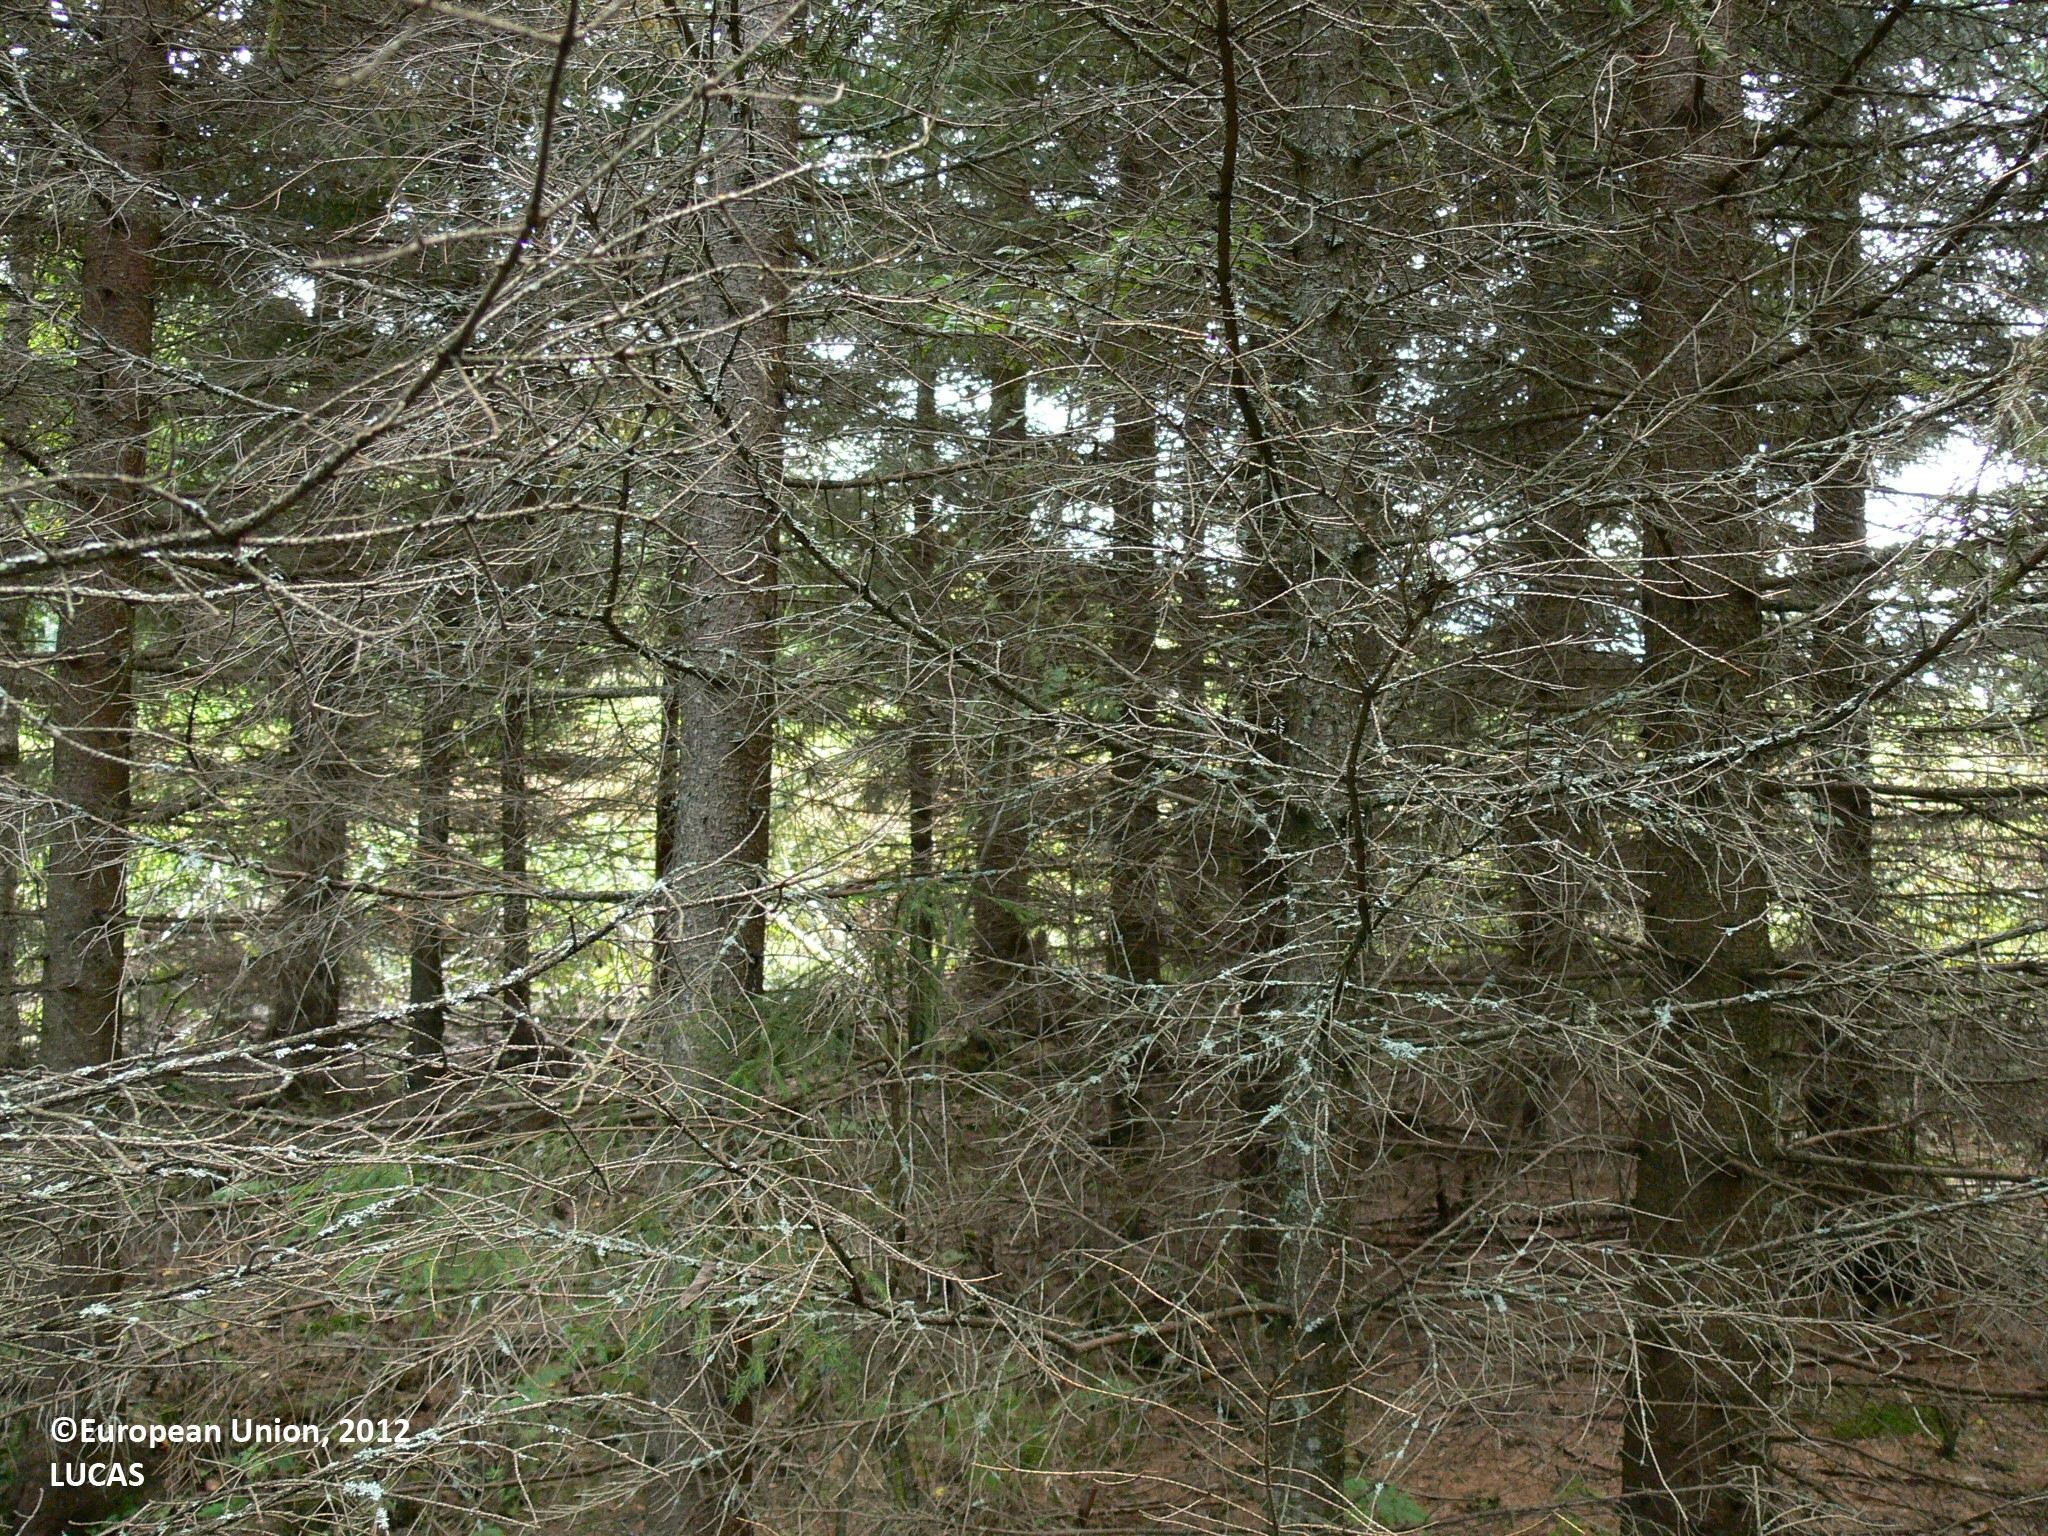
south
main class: Woodland
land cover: Spruce dominated coniferous woodland
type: boreal forest
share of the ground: > 75 %
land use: Forestry
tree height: > 5 m
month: August
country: FI
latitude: 61.9199
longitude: 30.1358
